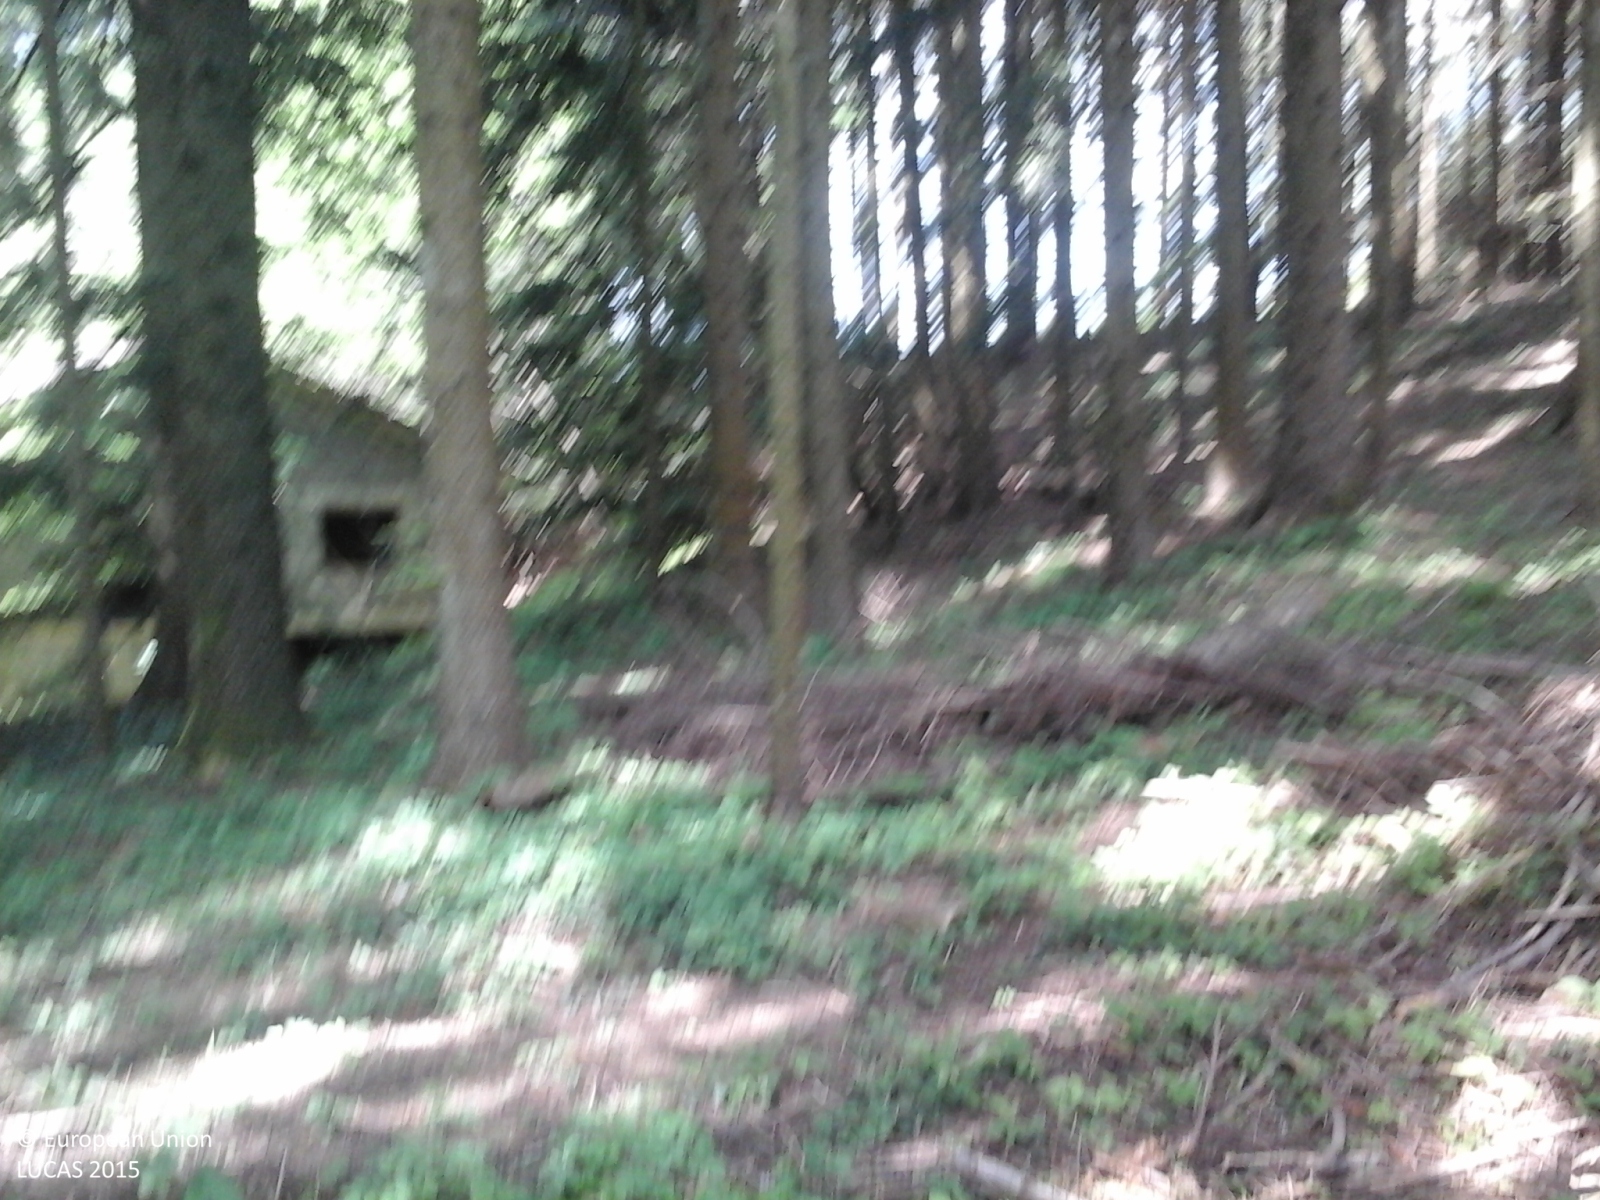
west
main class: Woodland
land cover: Spruce dominated coniferous woodland
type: alpine coniferous forest
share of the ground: > 75 %
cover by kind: coniferous forest trees 100 %
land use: Forestry
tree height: > 5 m
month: May
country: IT
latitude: 44.1093
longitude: 11.1840
